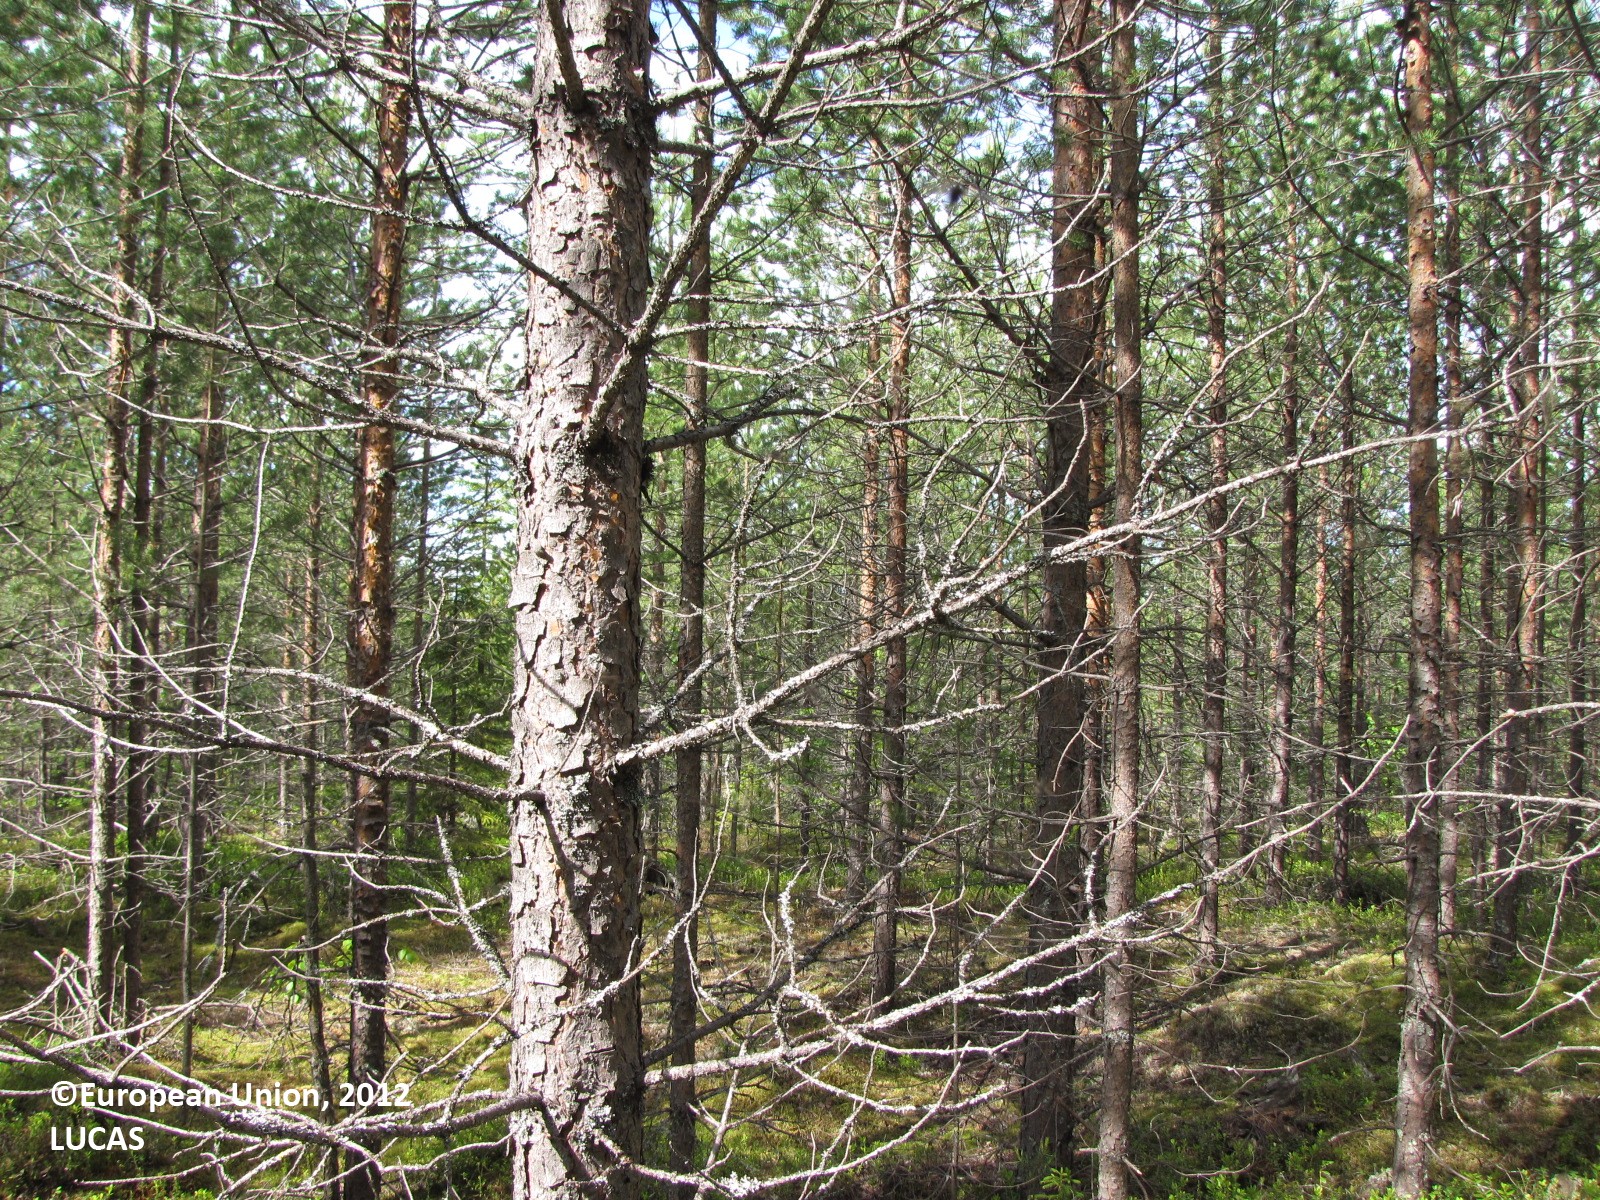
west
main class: Woodland
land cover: Pine dominated coniferous woodland
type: boreal forest
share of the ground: 50 - 75 %
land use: Forestry
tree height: > 5 m
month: July
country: FI
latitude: 66.1342
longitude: 25.2360
